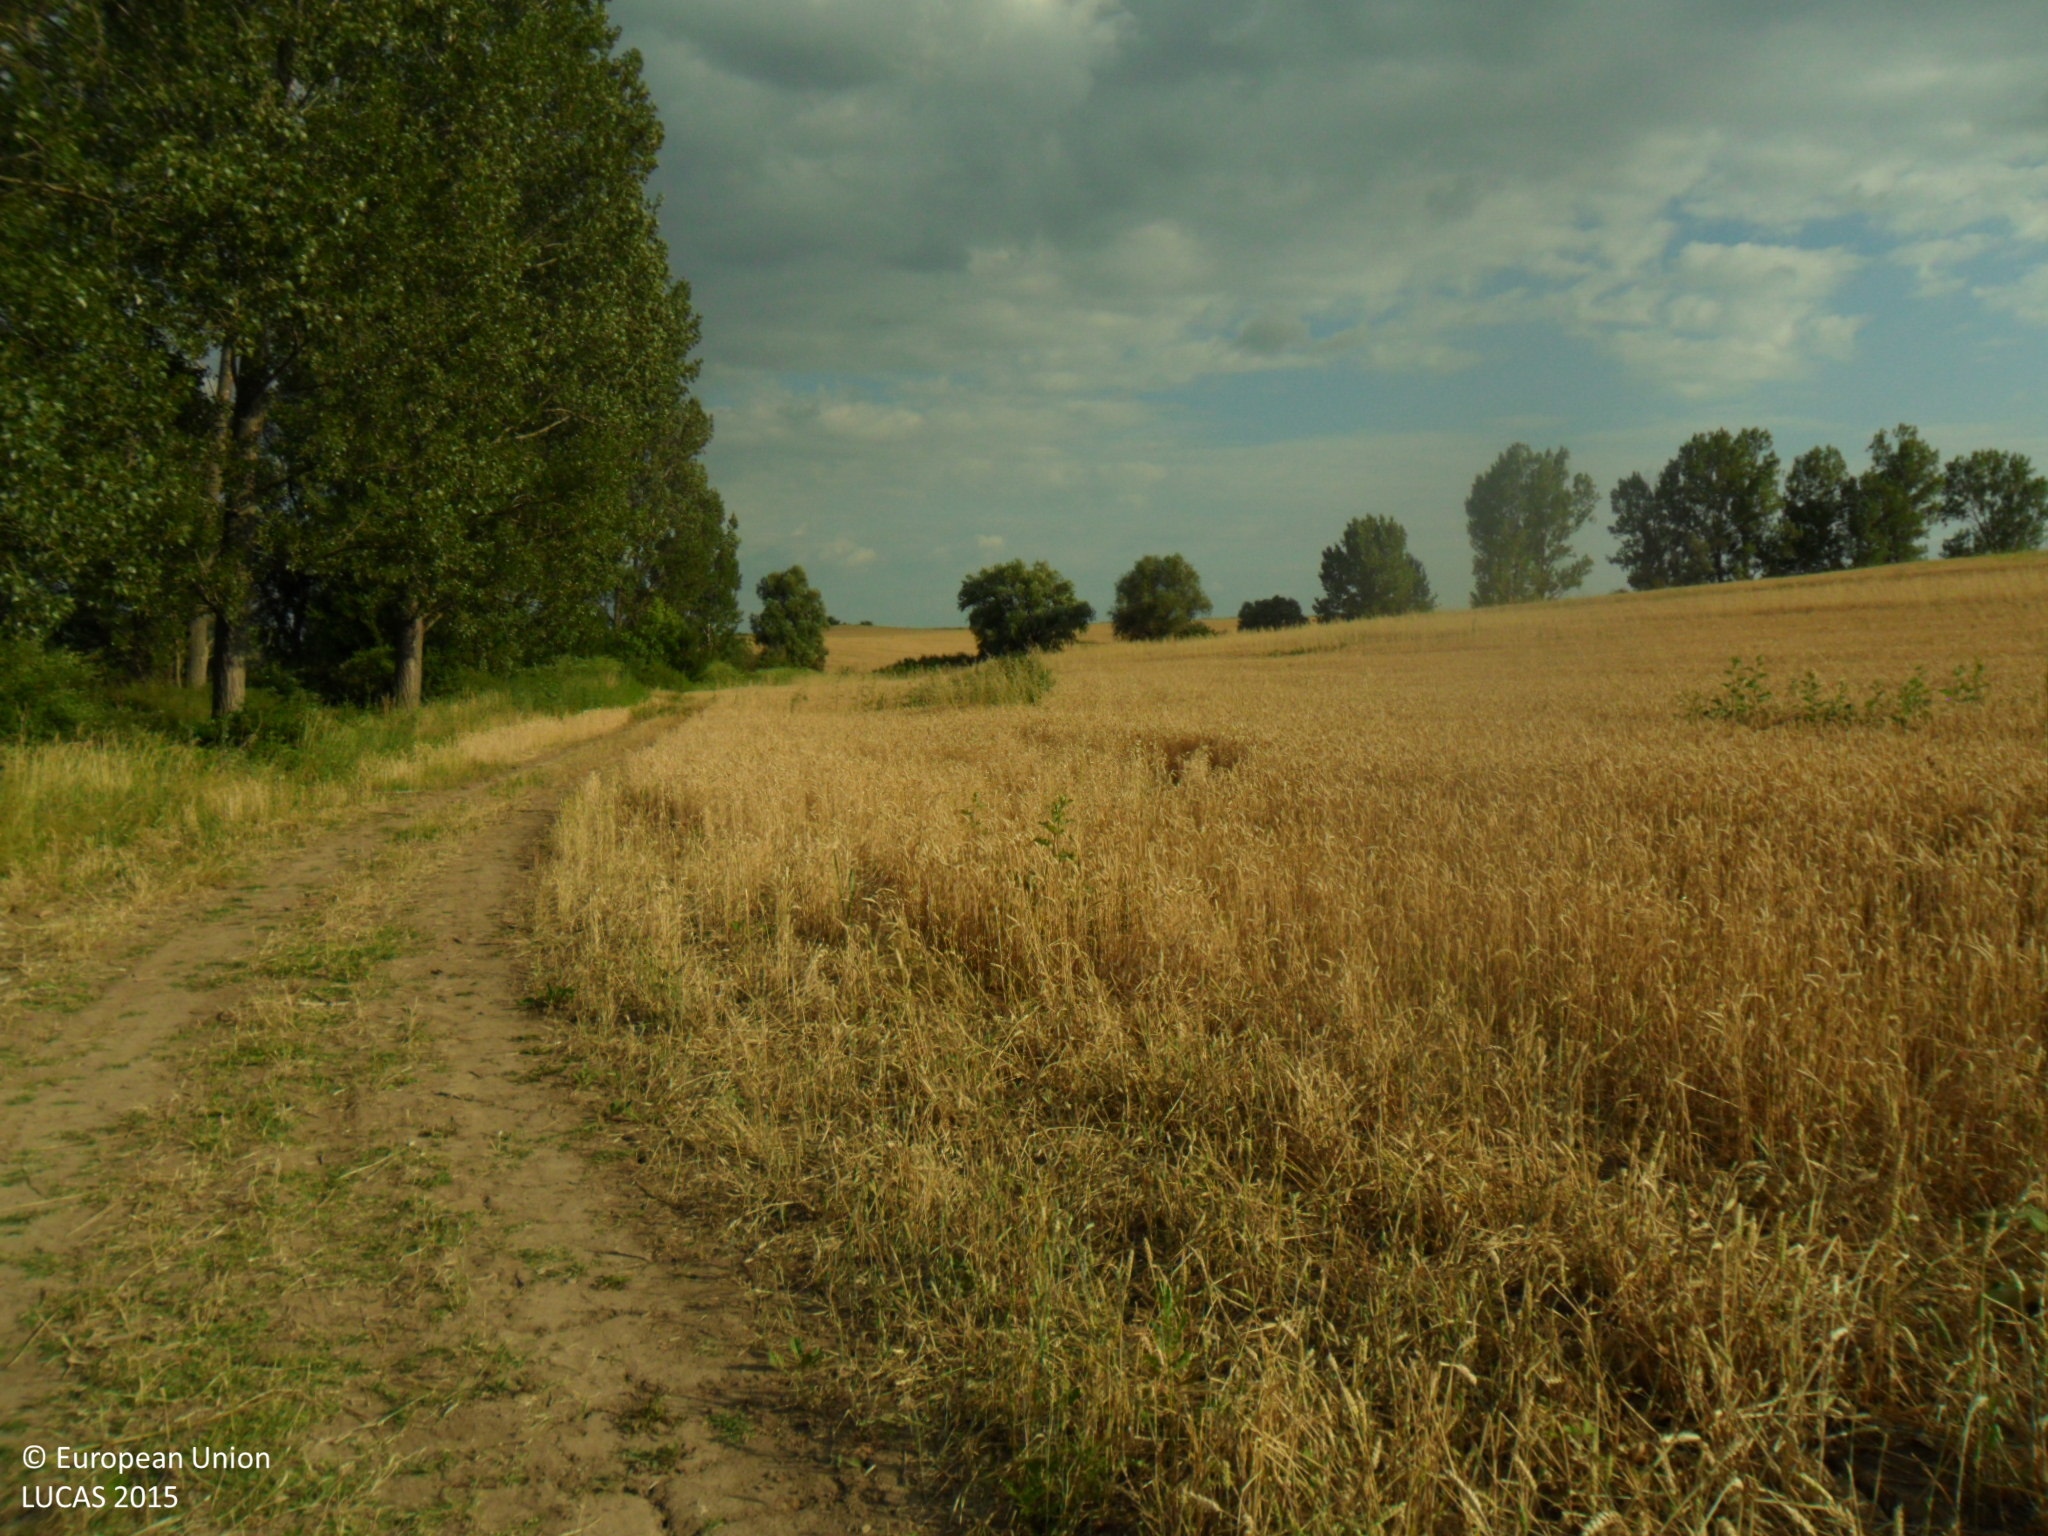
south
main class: Cropland
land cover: Common wheat
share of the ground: > 75 %
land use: Agriculture (excluding fallow land and kitchen gardens)
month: June
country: BG
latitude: 43.2211
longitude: 26.9415
